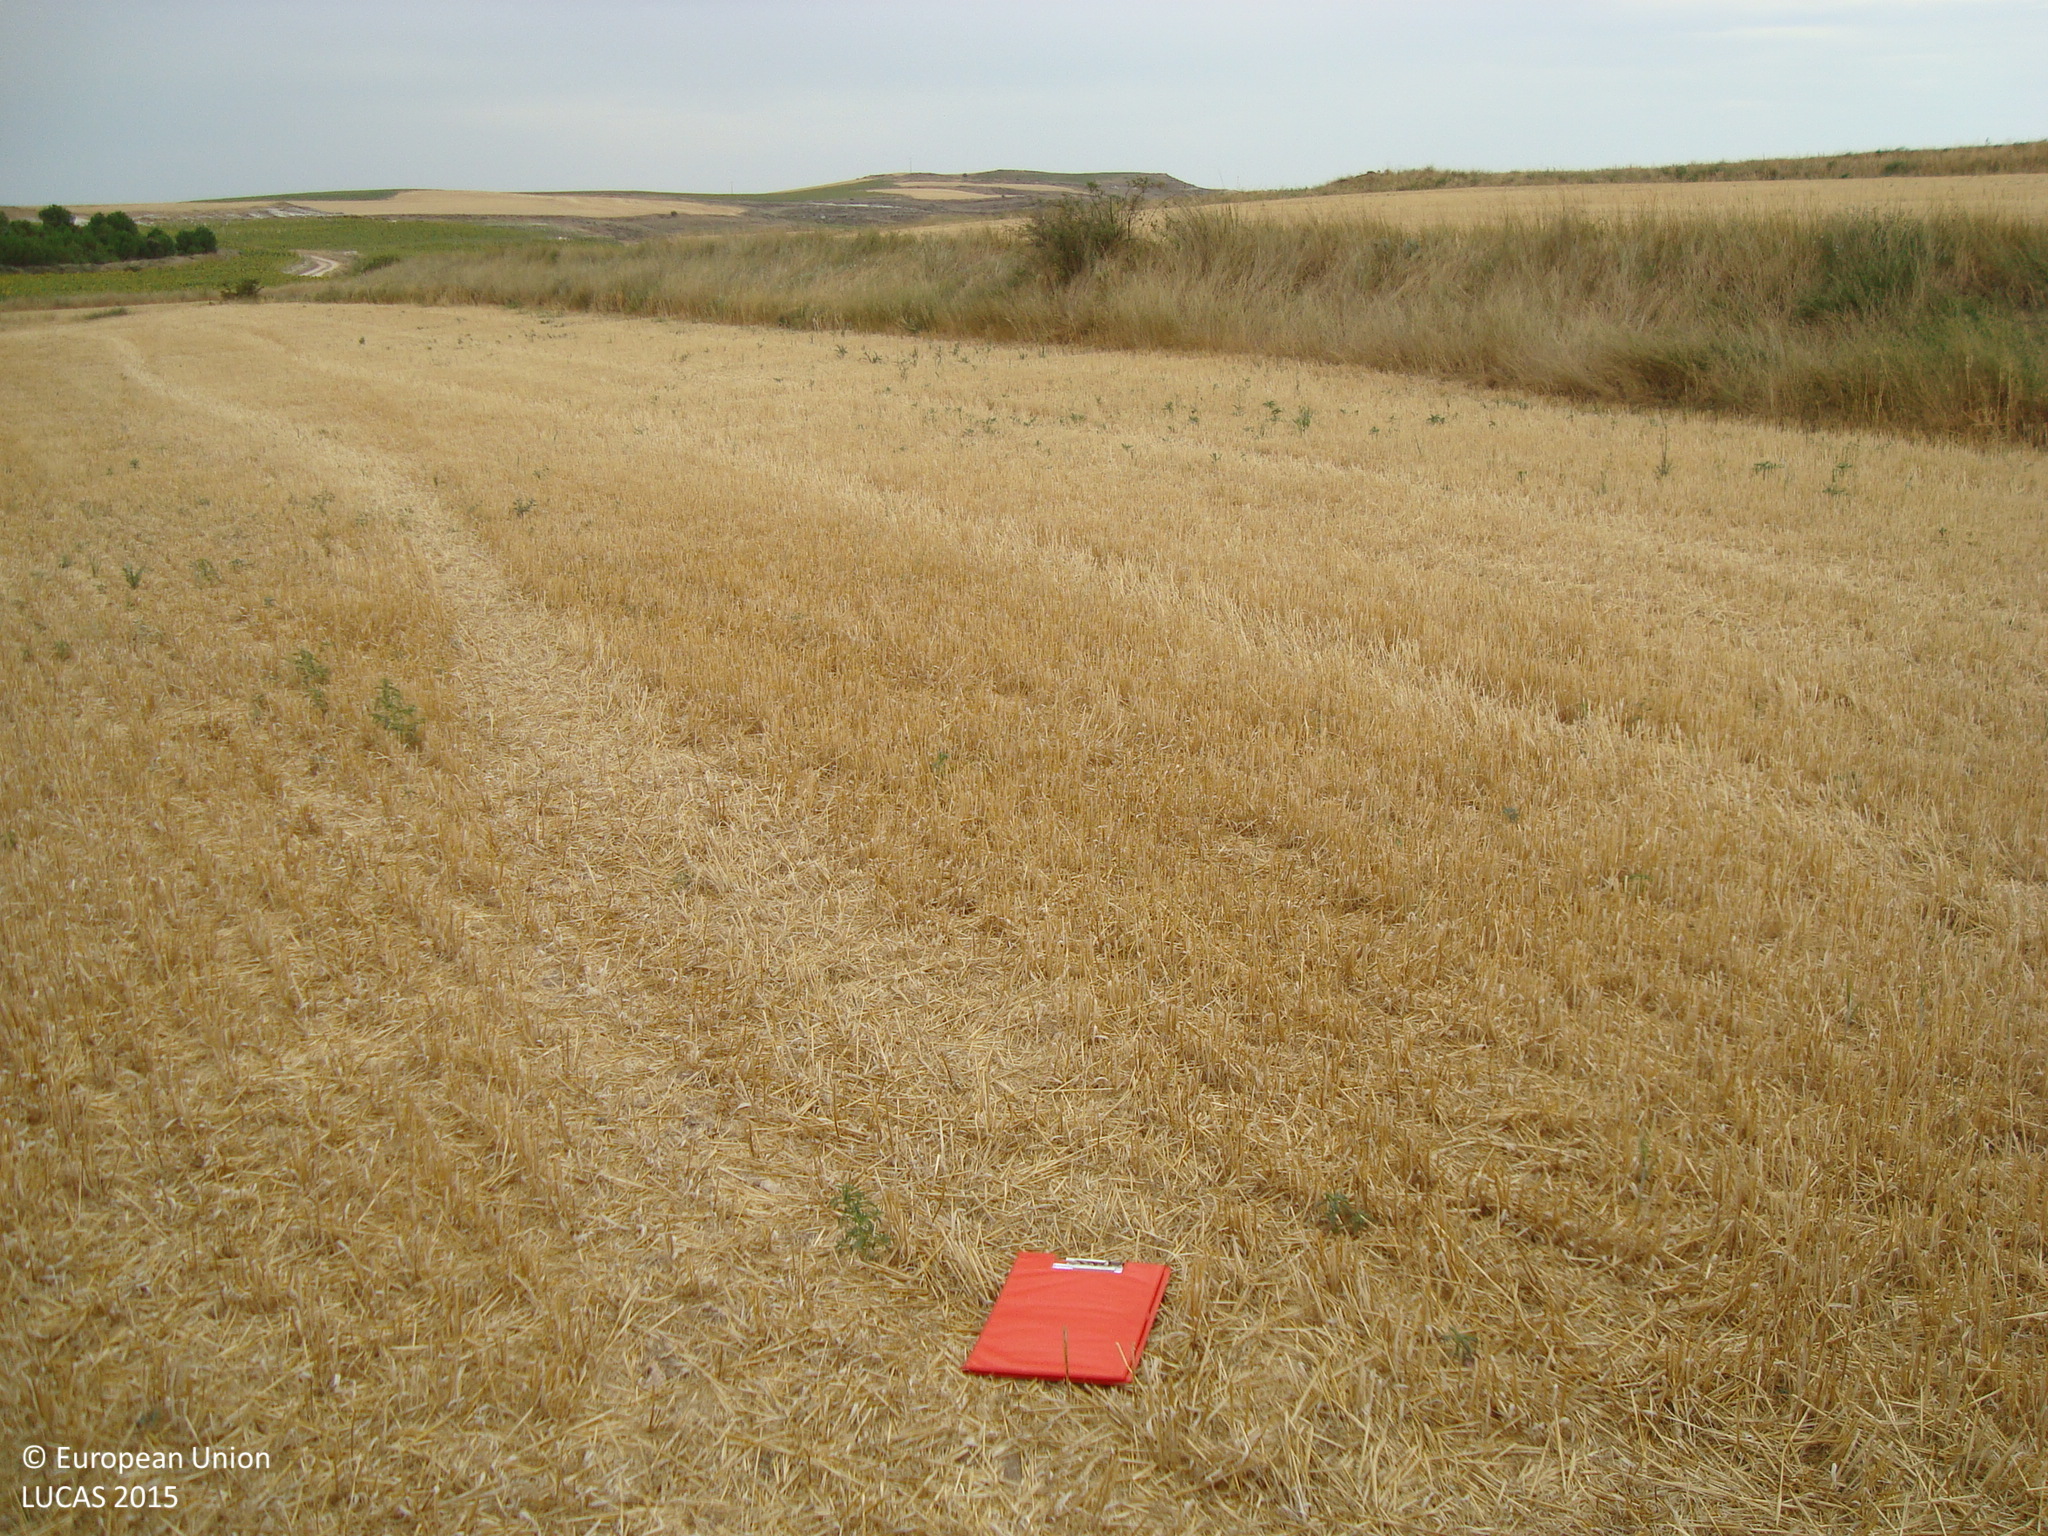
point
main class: Cropland
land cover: Common wheat
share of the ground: > 75 %
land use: Agriculture (excluding fallow land and kitchen gardens)
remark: Harvested field
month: August
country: ES
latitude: 42.2164
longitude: -3.9332
